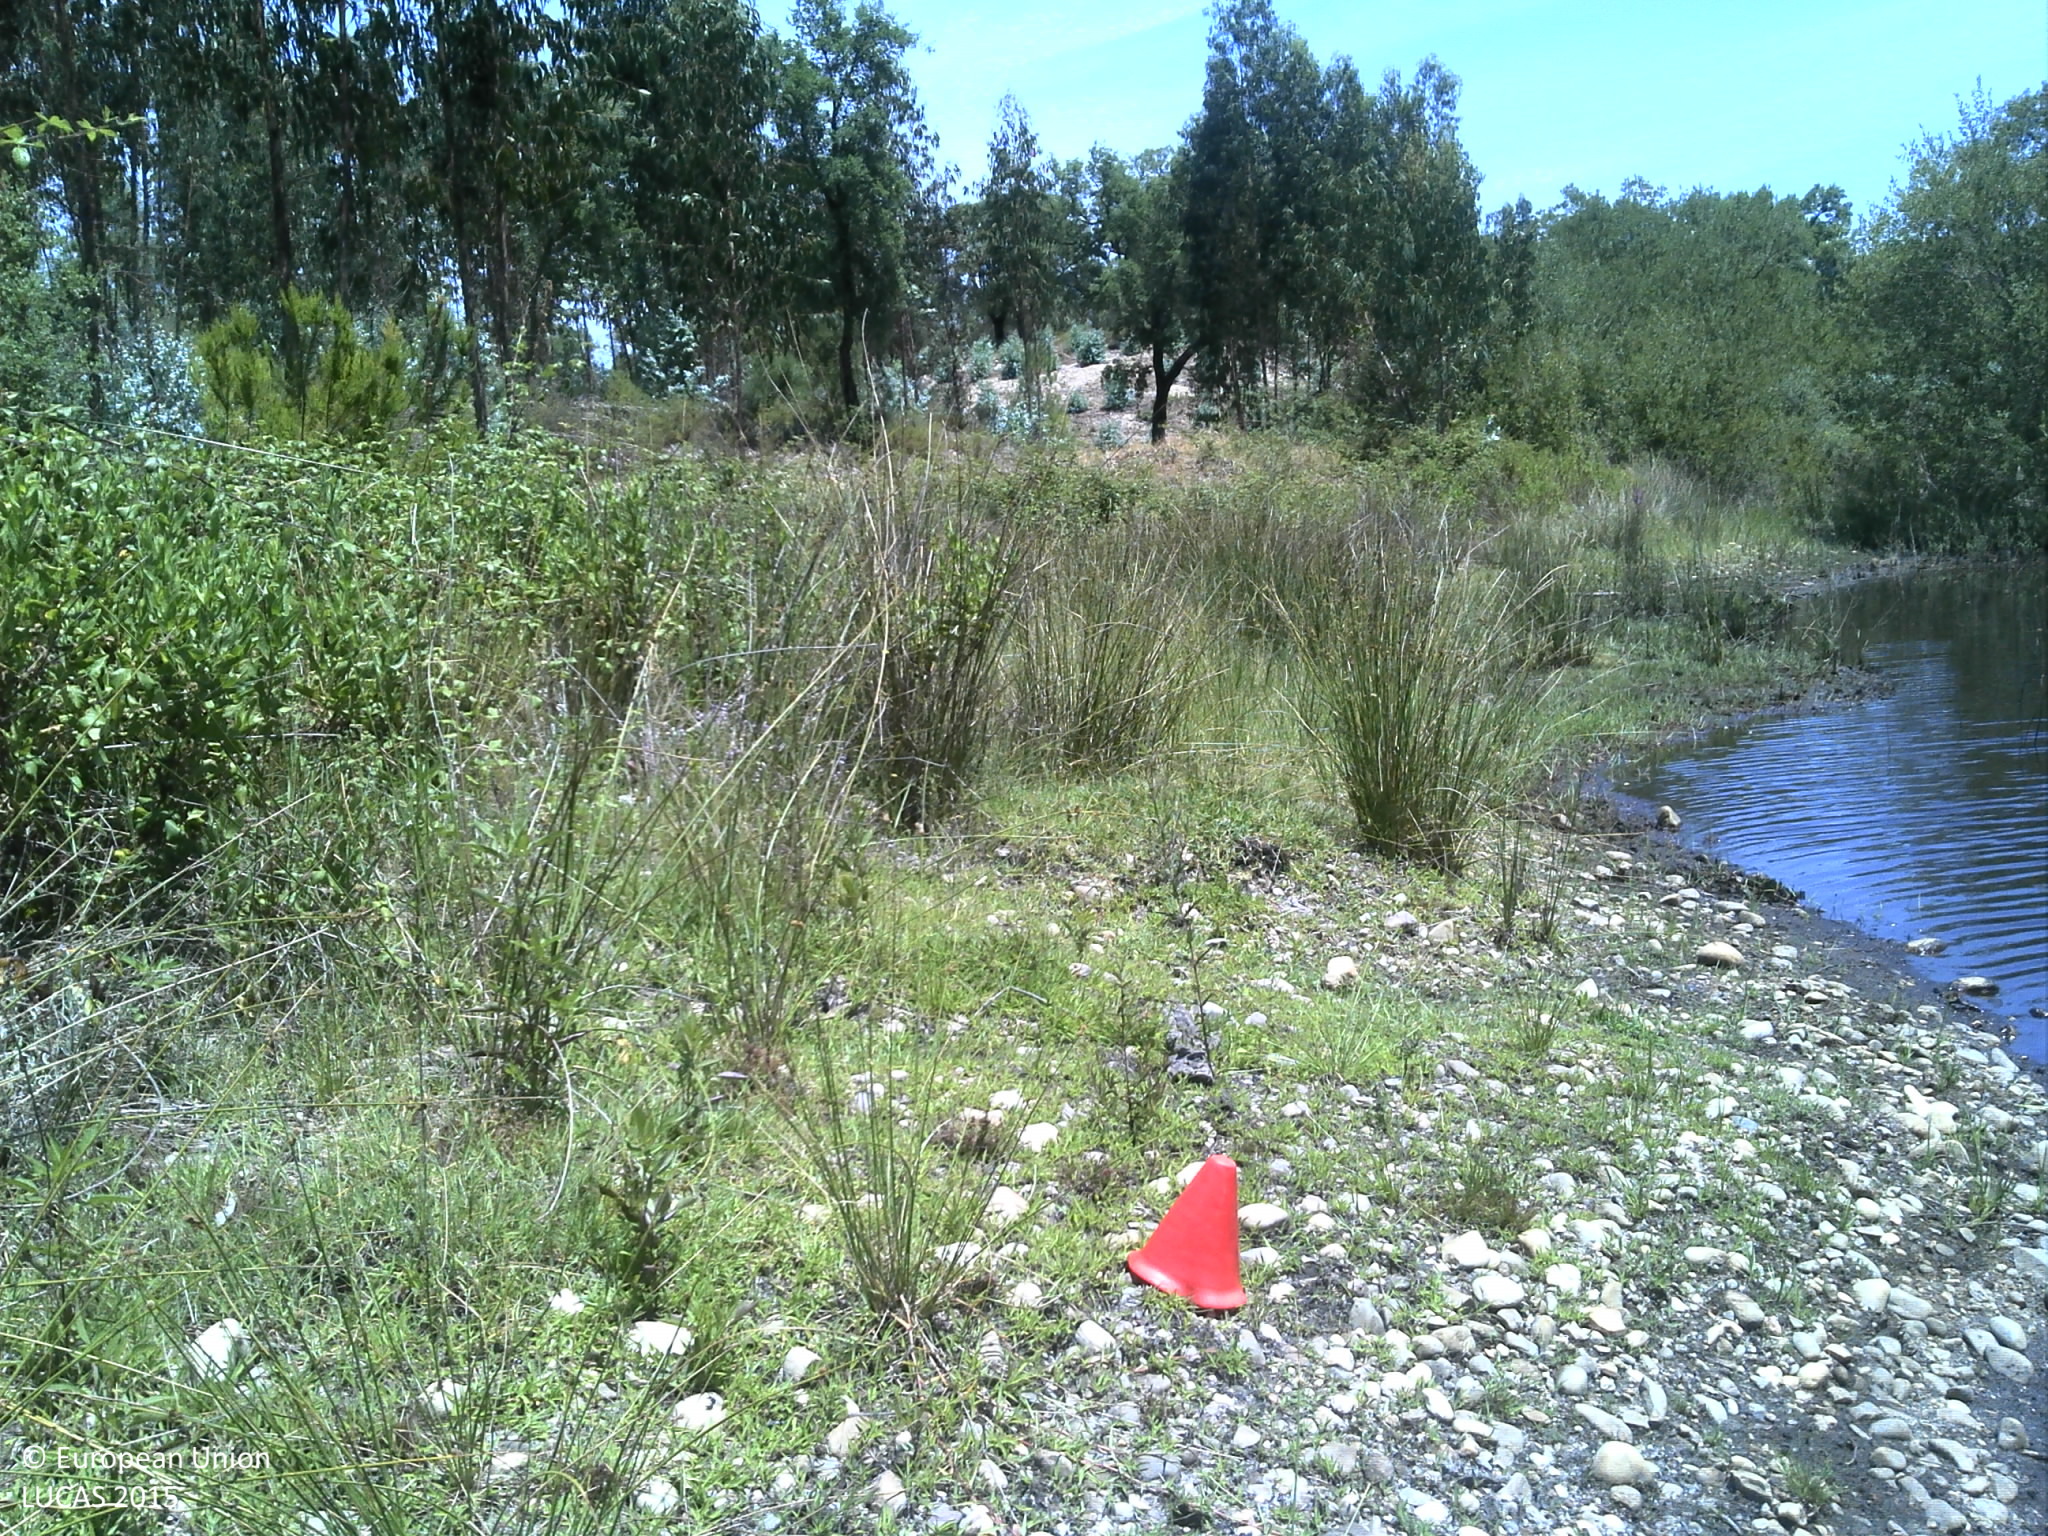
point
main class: Shrubland
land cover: Shrubland without tree cover
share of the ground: 25 - 50 %
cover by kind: unconsolidated bare surface 50 %, shrubs 40 %, herbaceous plants 10 %
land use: Semi-natural and natural areas not in use
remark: Temporary dry
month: July
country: PT
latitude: 39.2527
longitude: -8.2901
